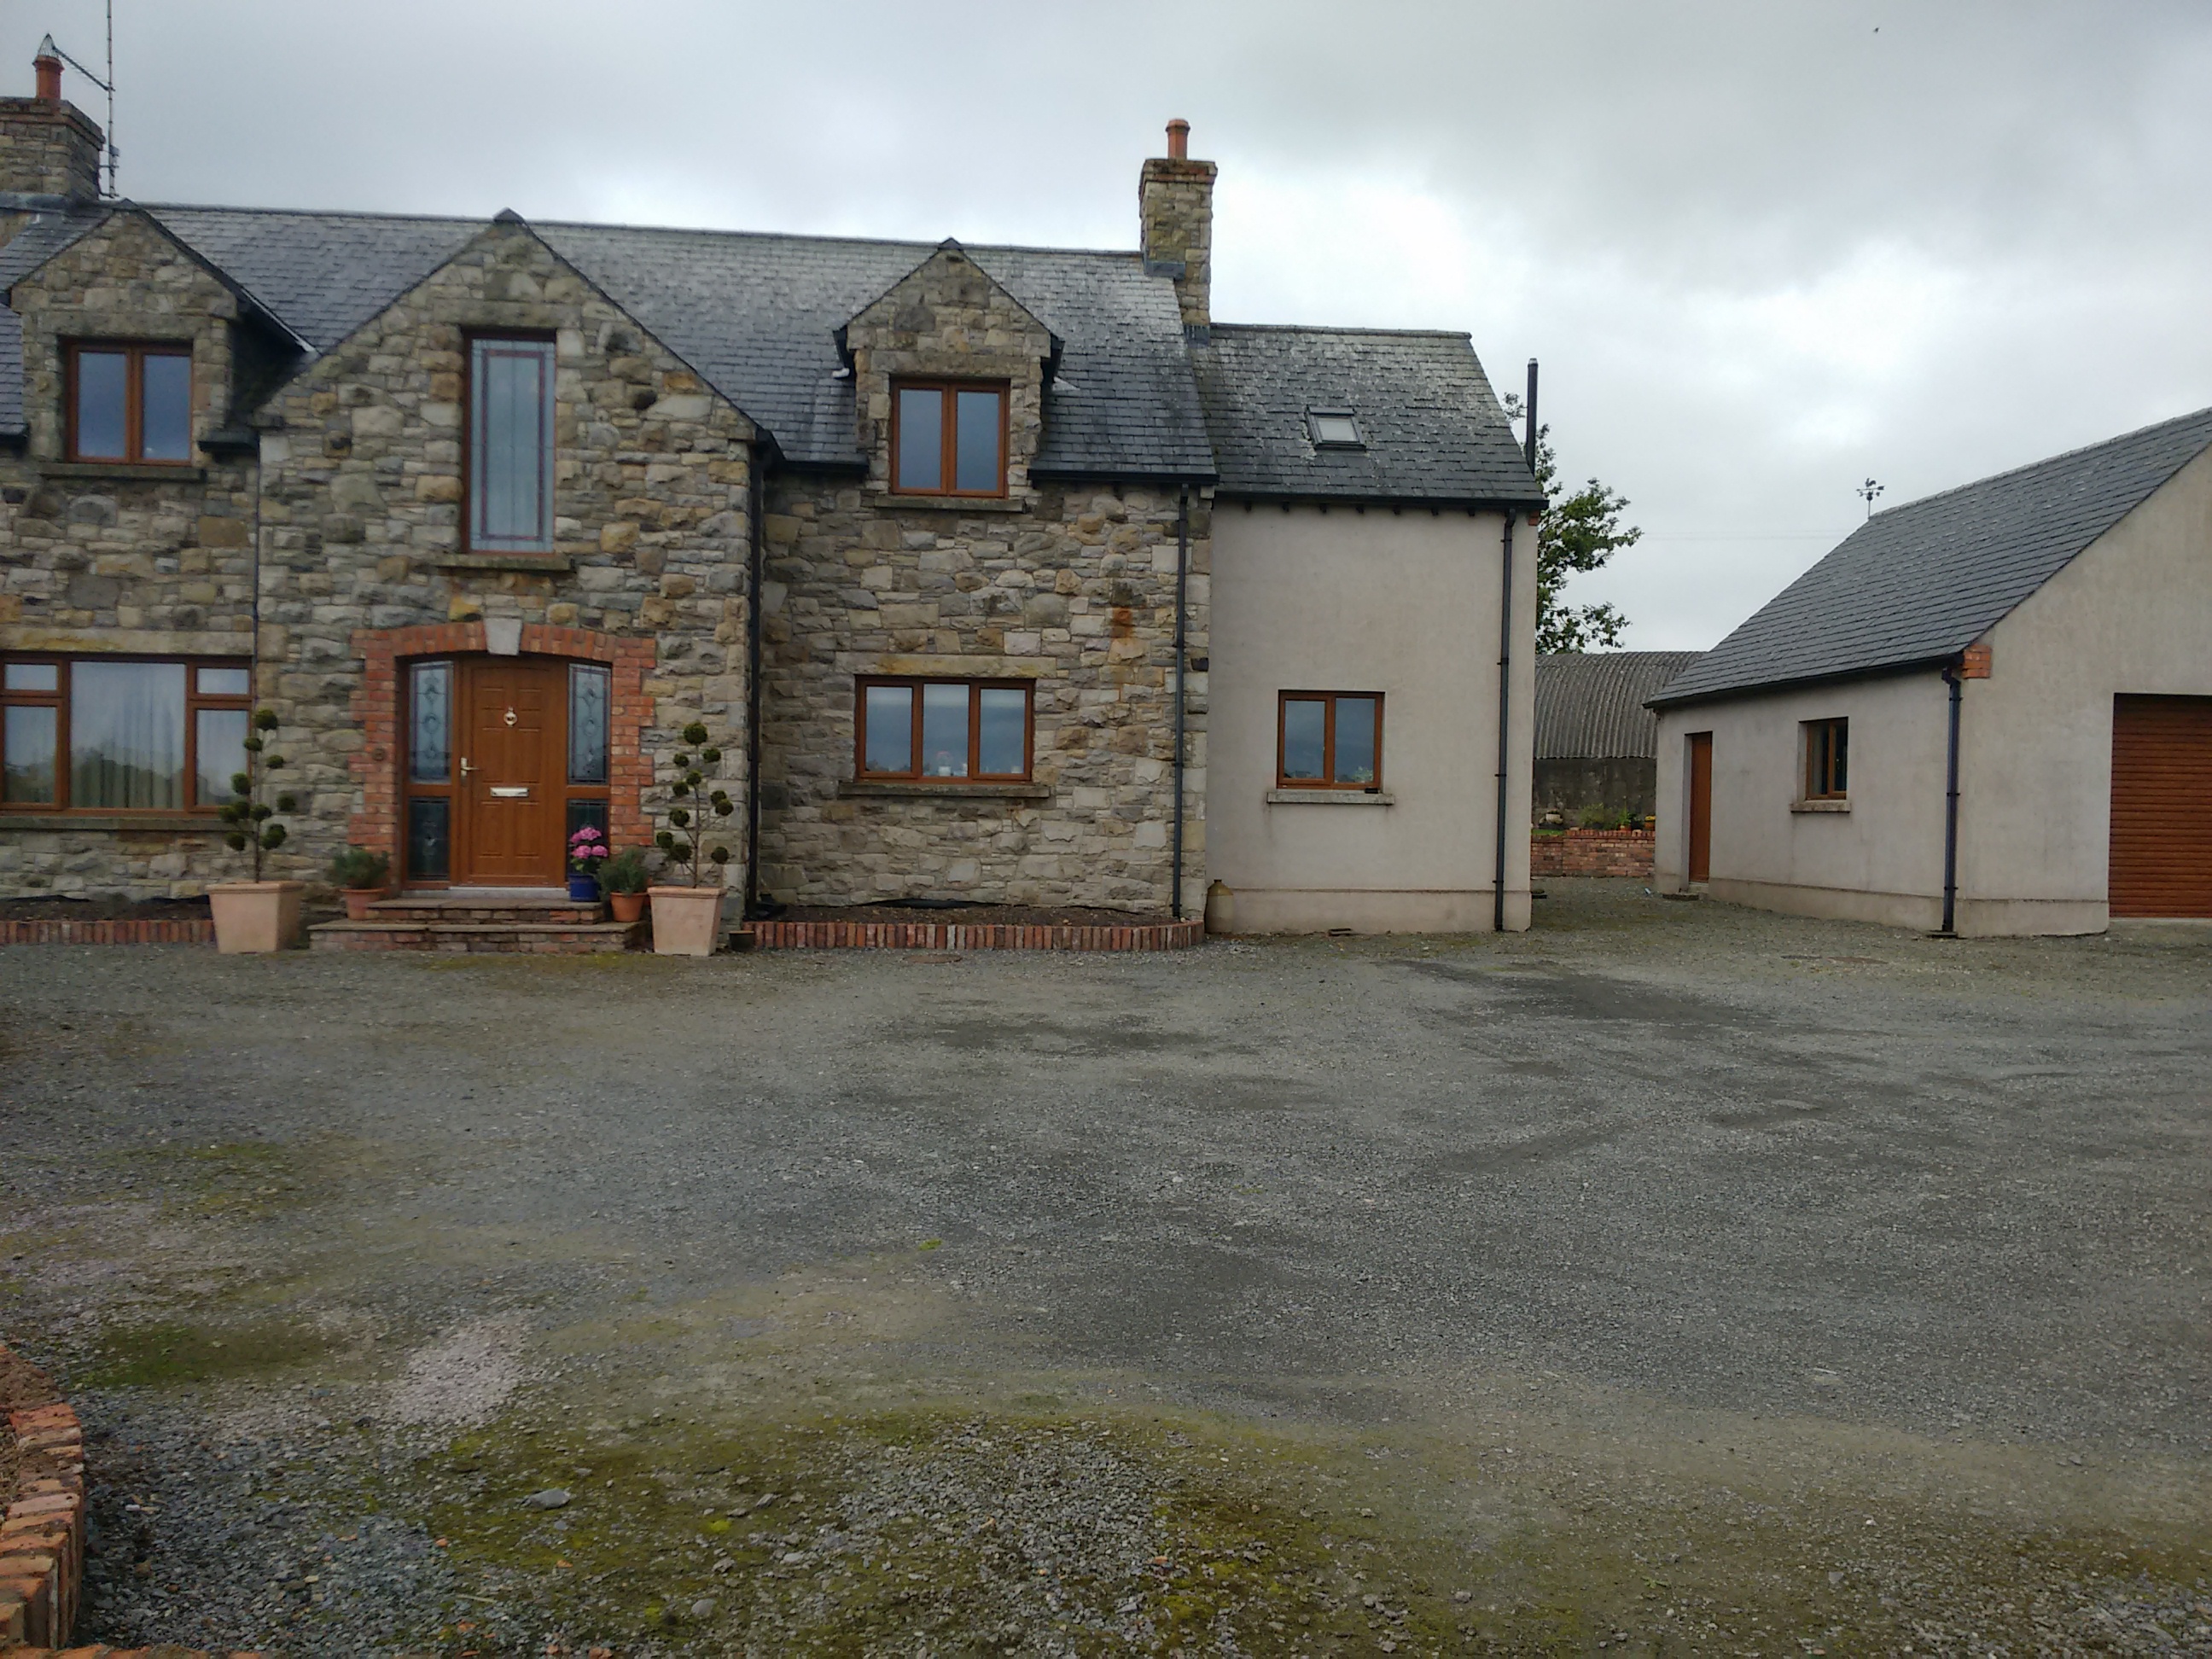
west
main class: Grassland
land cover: Grassland without tree/shrub cover
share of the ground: > 75 %
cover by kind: herbaceous plants 100 %
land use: Agriculture (excluding fallow land and kitchen gardens)
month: August
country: GB
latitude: 54.4109
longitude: -6.7574
